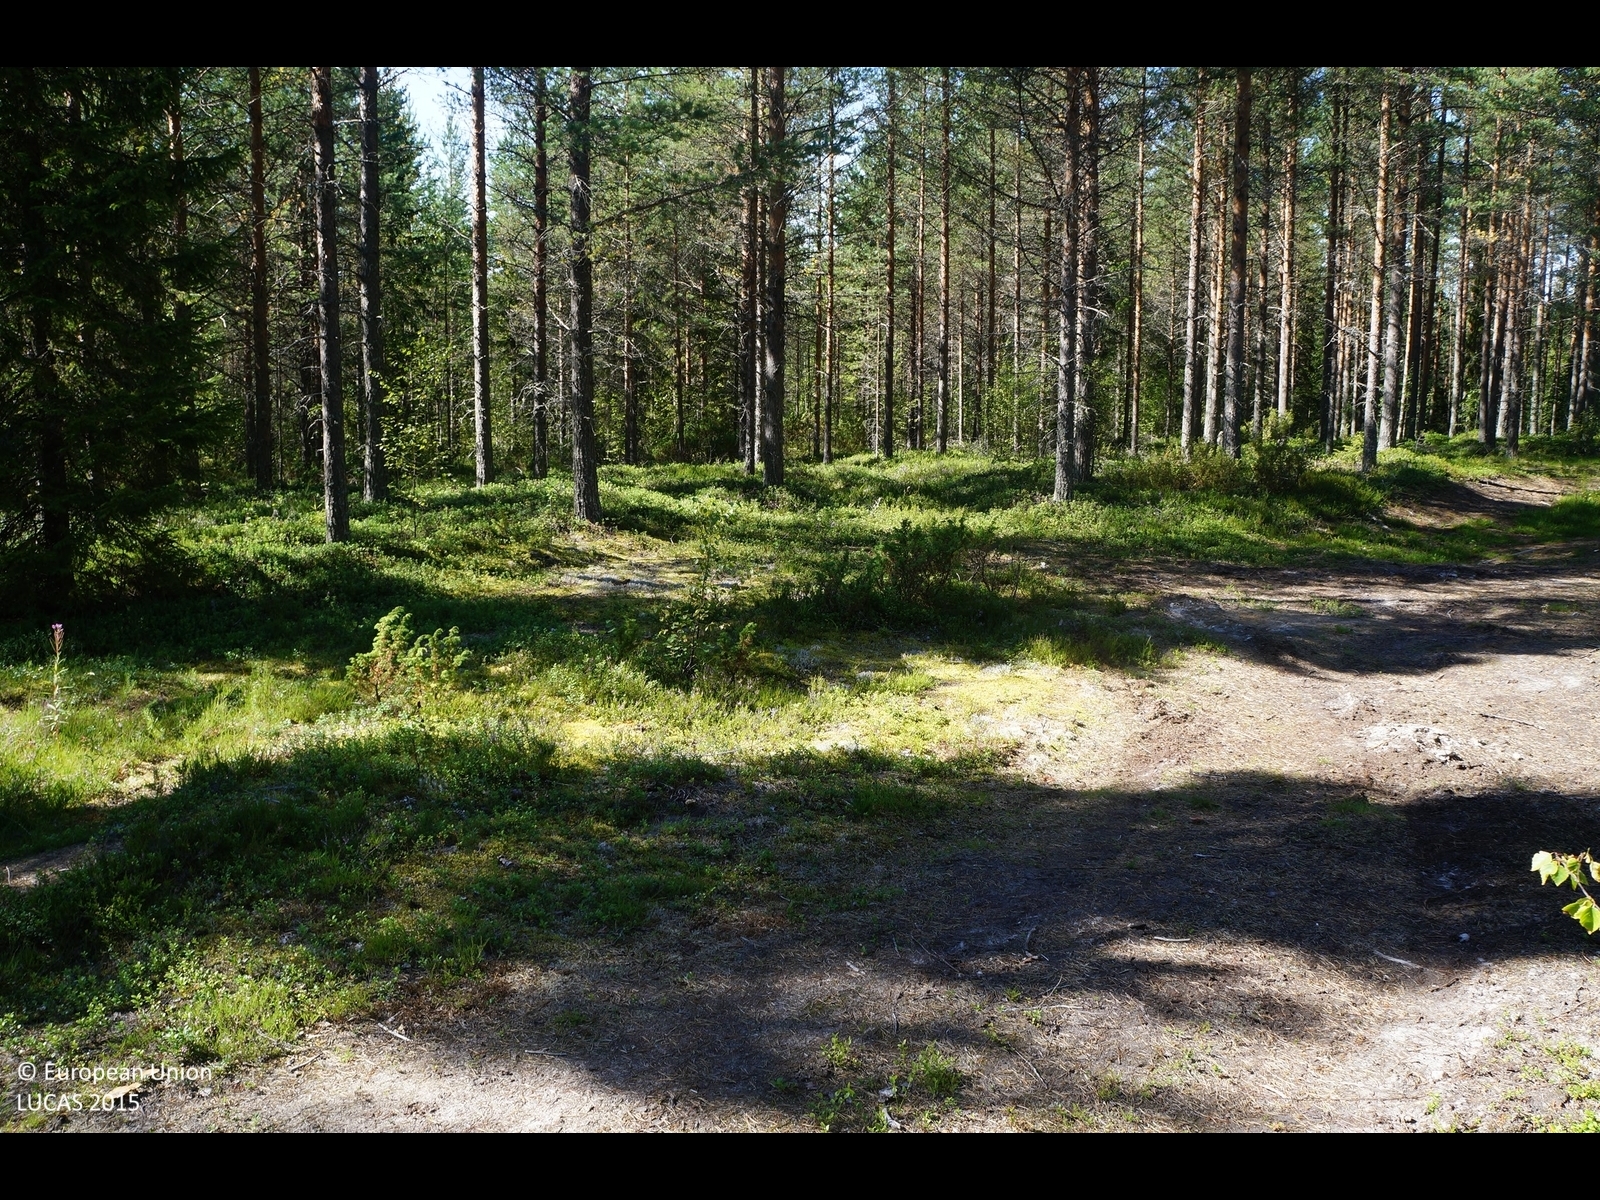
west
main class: Woodland
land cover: Pine dominated coniferous woodland
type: boreal forest
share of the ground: 50 - 75 %
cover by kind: coniferous forest trees 60 %, shrubs 30 %, lichens and mosses 10 %
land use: Forestry
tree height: > 5 m
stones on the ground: < 10 %
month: August
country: FI
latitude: 64.5961
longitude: 24.6748
